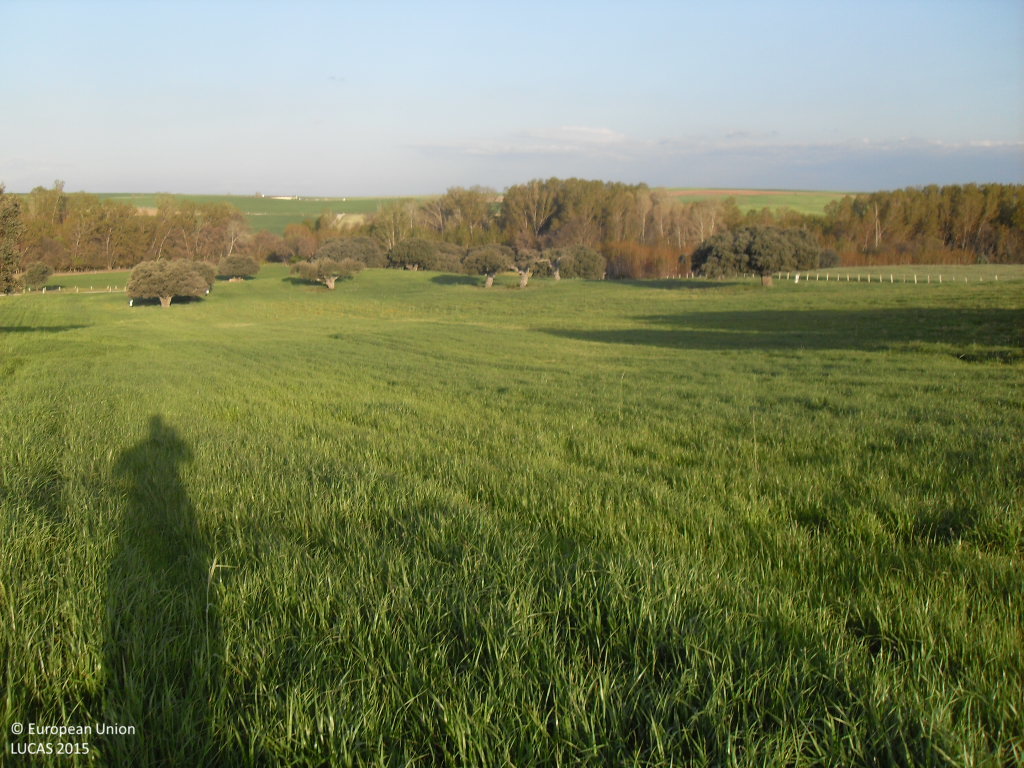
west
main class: Cropland
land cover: Barley
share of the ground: > 75 %
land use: Agriculture (excluding fallow land and kitchen gardens)
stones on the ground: < 10 %
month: April
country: ES
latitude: 40.7338
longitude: -5.2824
